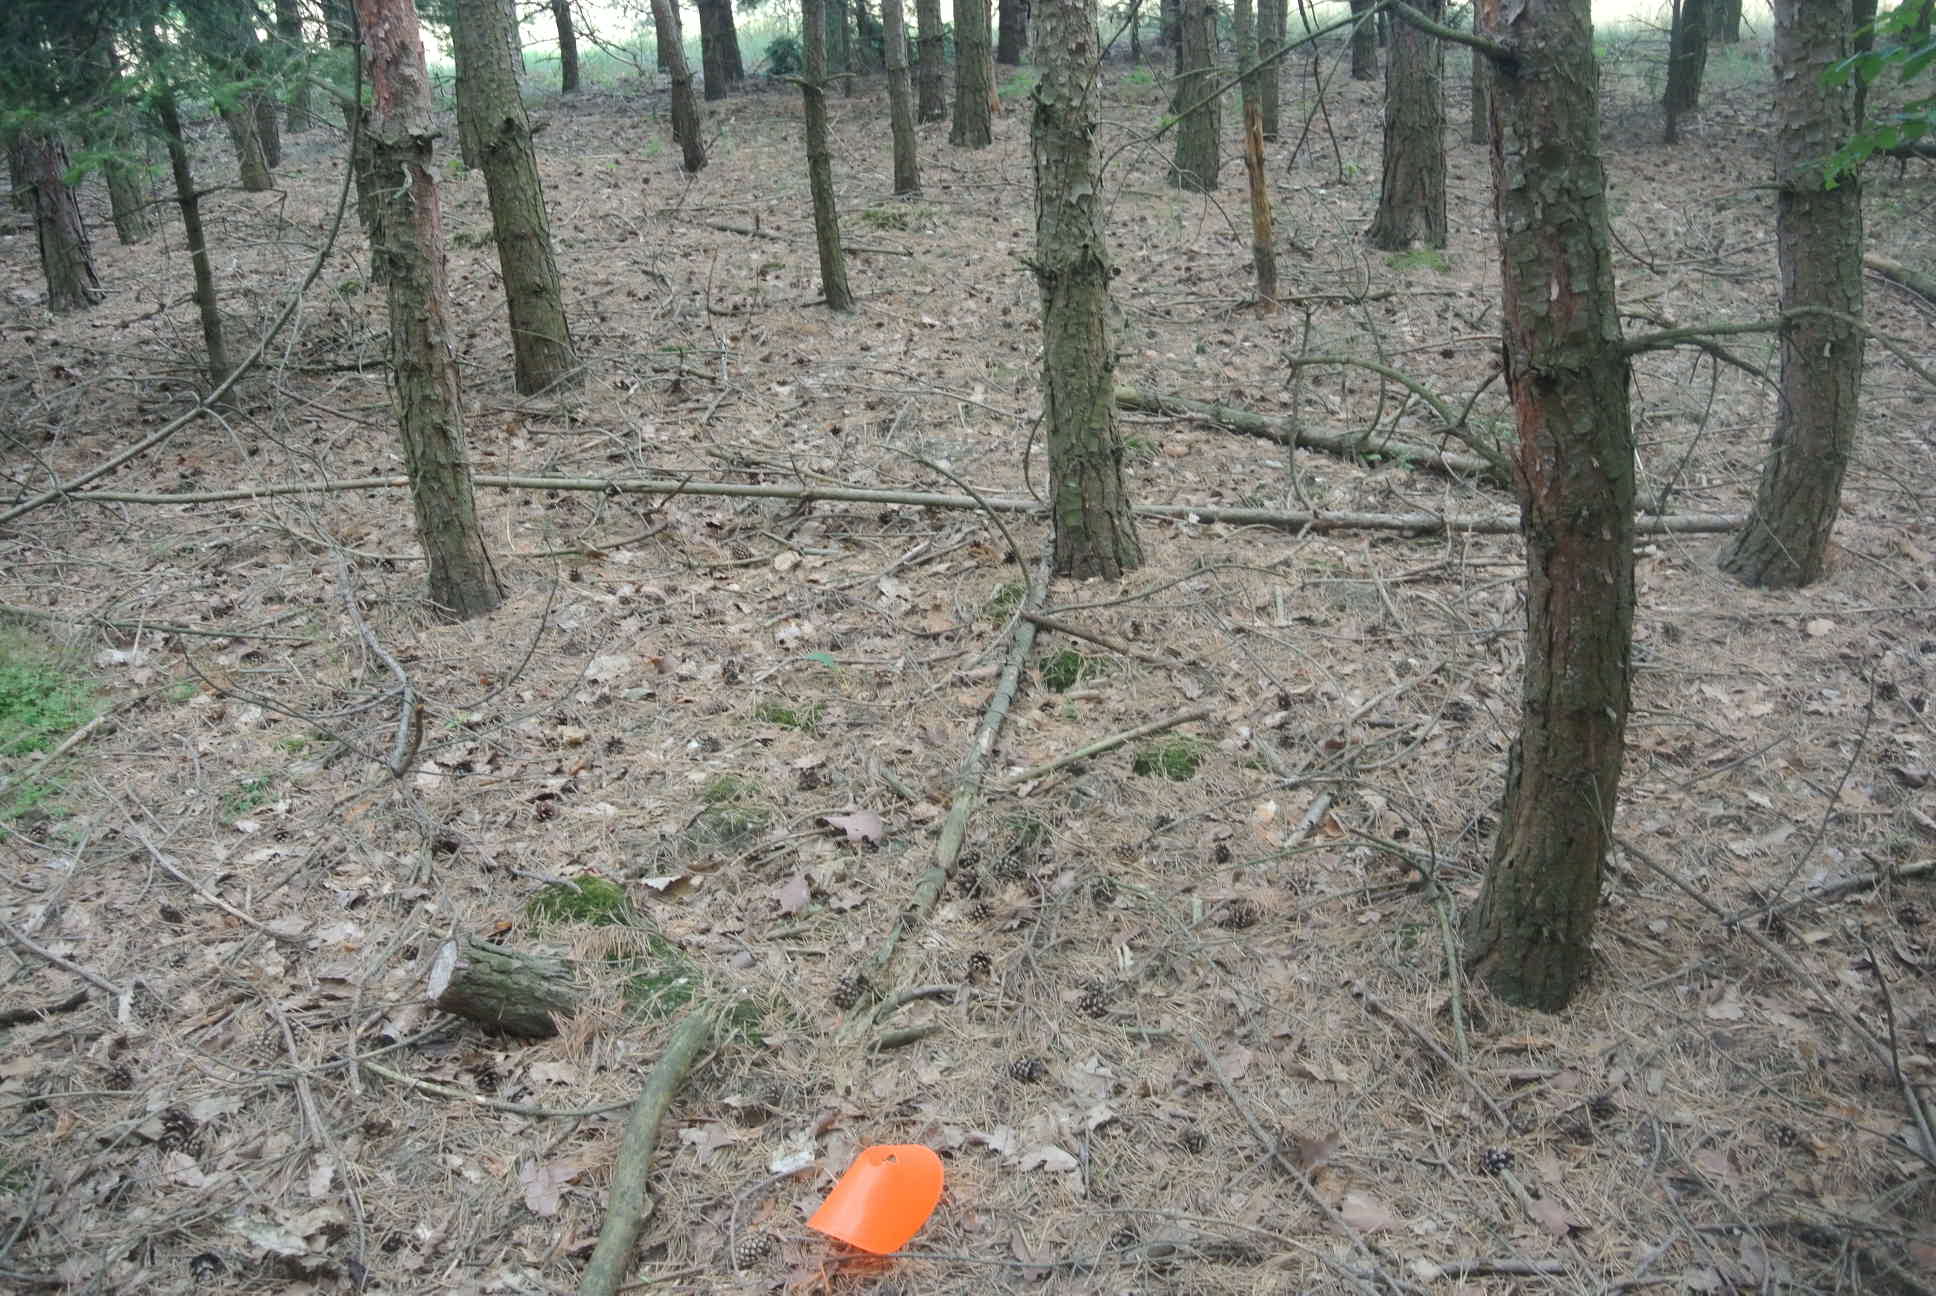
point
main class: Woodland
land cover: Pine dominated coniferous woodland
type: alpine coniferous forest
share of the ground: > 75 %
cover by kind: coniferous forest trees 90 %, unconsolidated bare surface 10 %
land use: Forestry
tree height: > 5 m
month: July
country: AT
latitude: 47.4429
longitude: 16.3817
